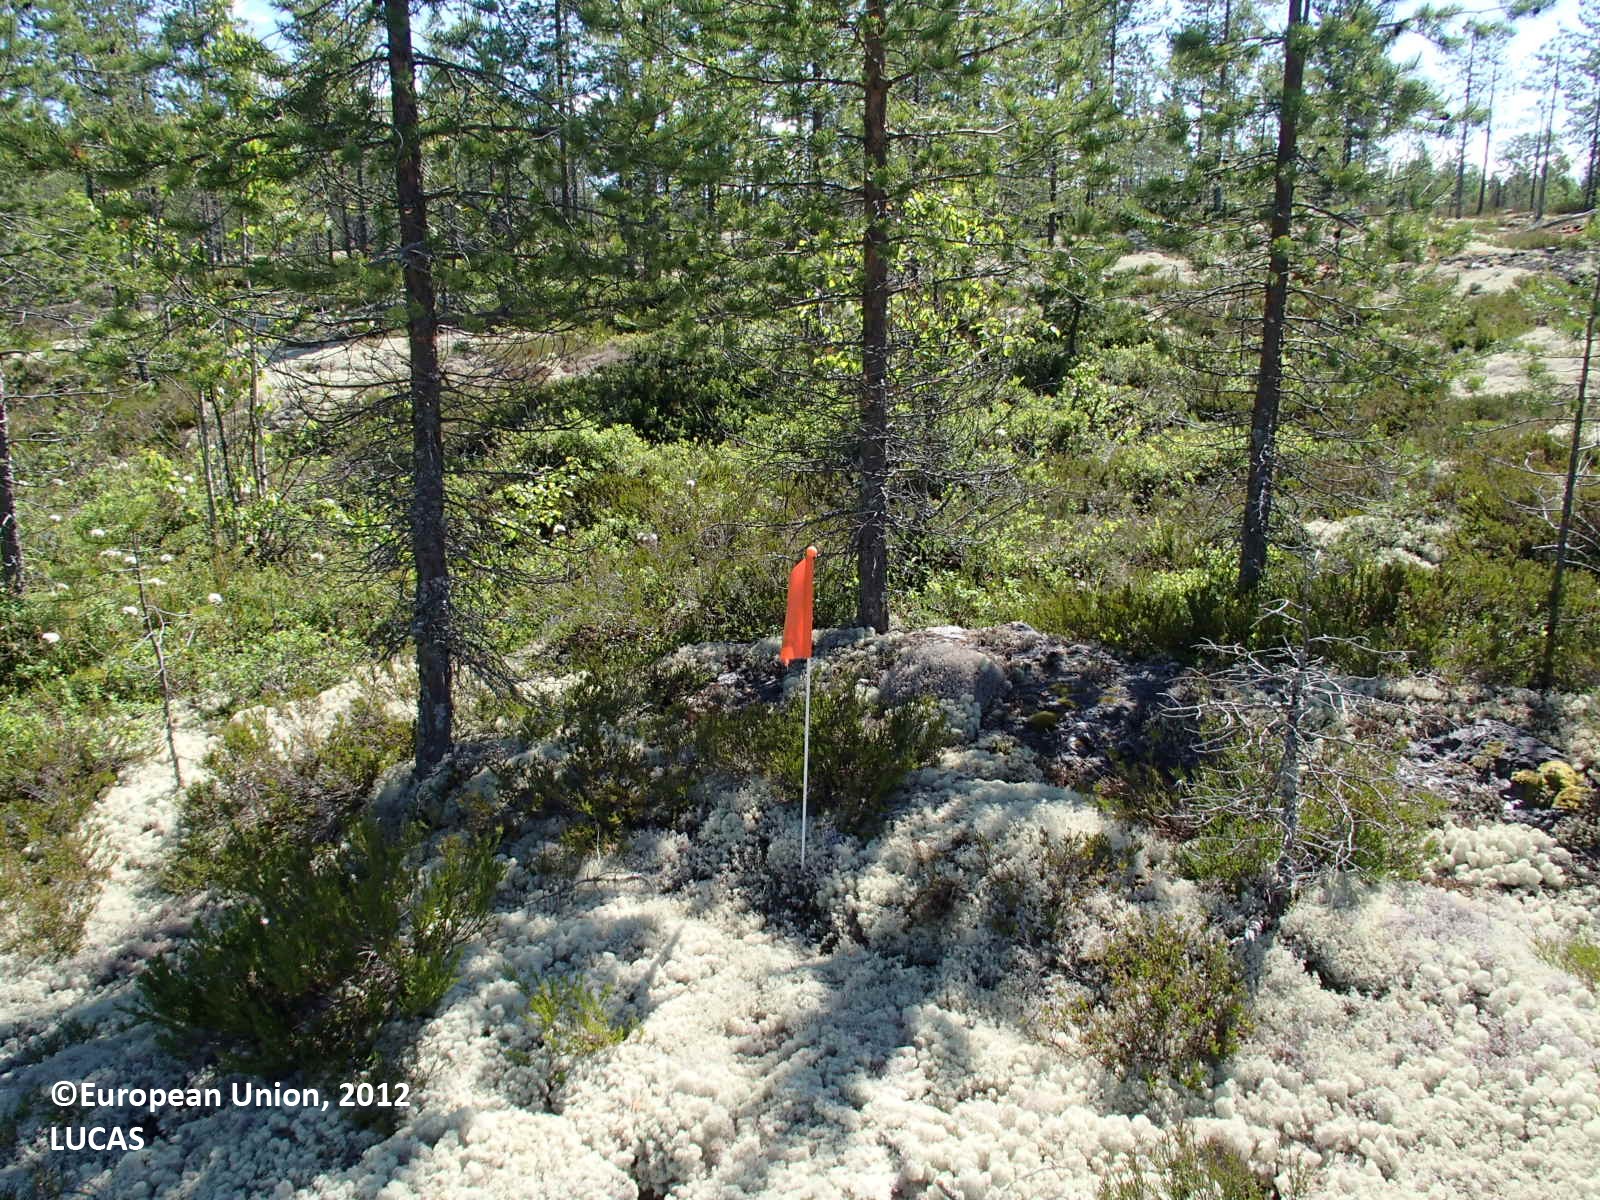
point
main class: Woodland
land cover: Pine dominated coniferous woodland
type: boreal forest
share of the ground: 25 - 50 %
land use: Forestry
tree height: < 5 m
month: June
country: FI
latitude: 64.2077
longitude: 27.3847
